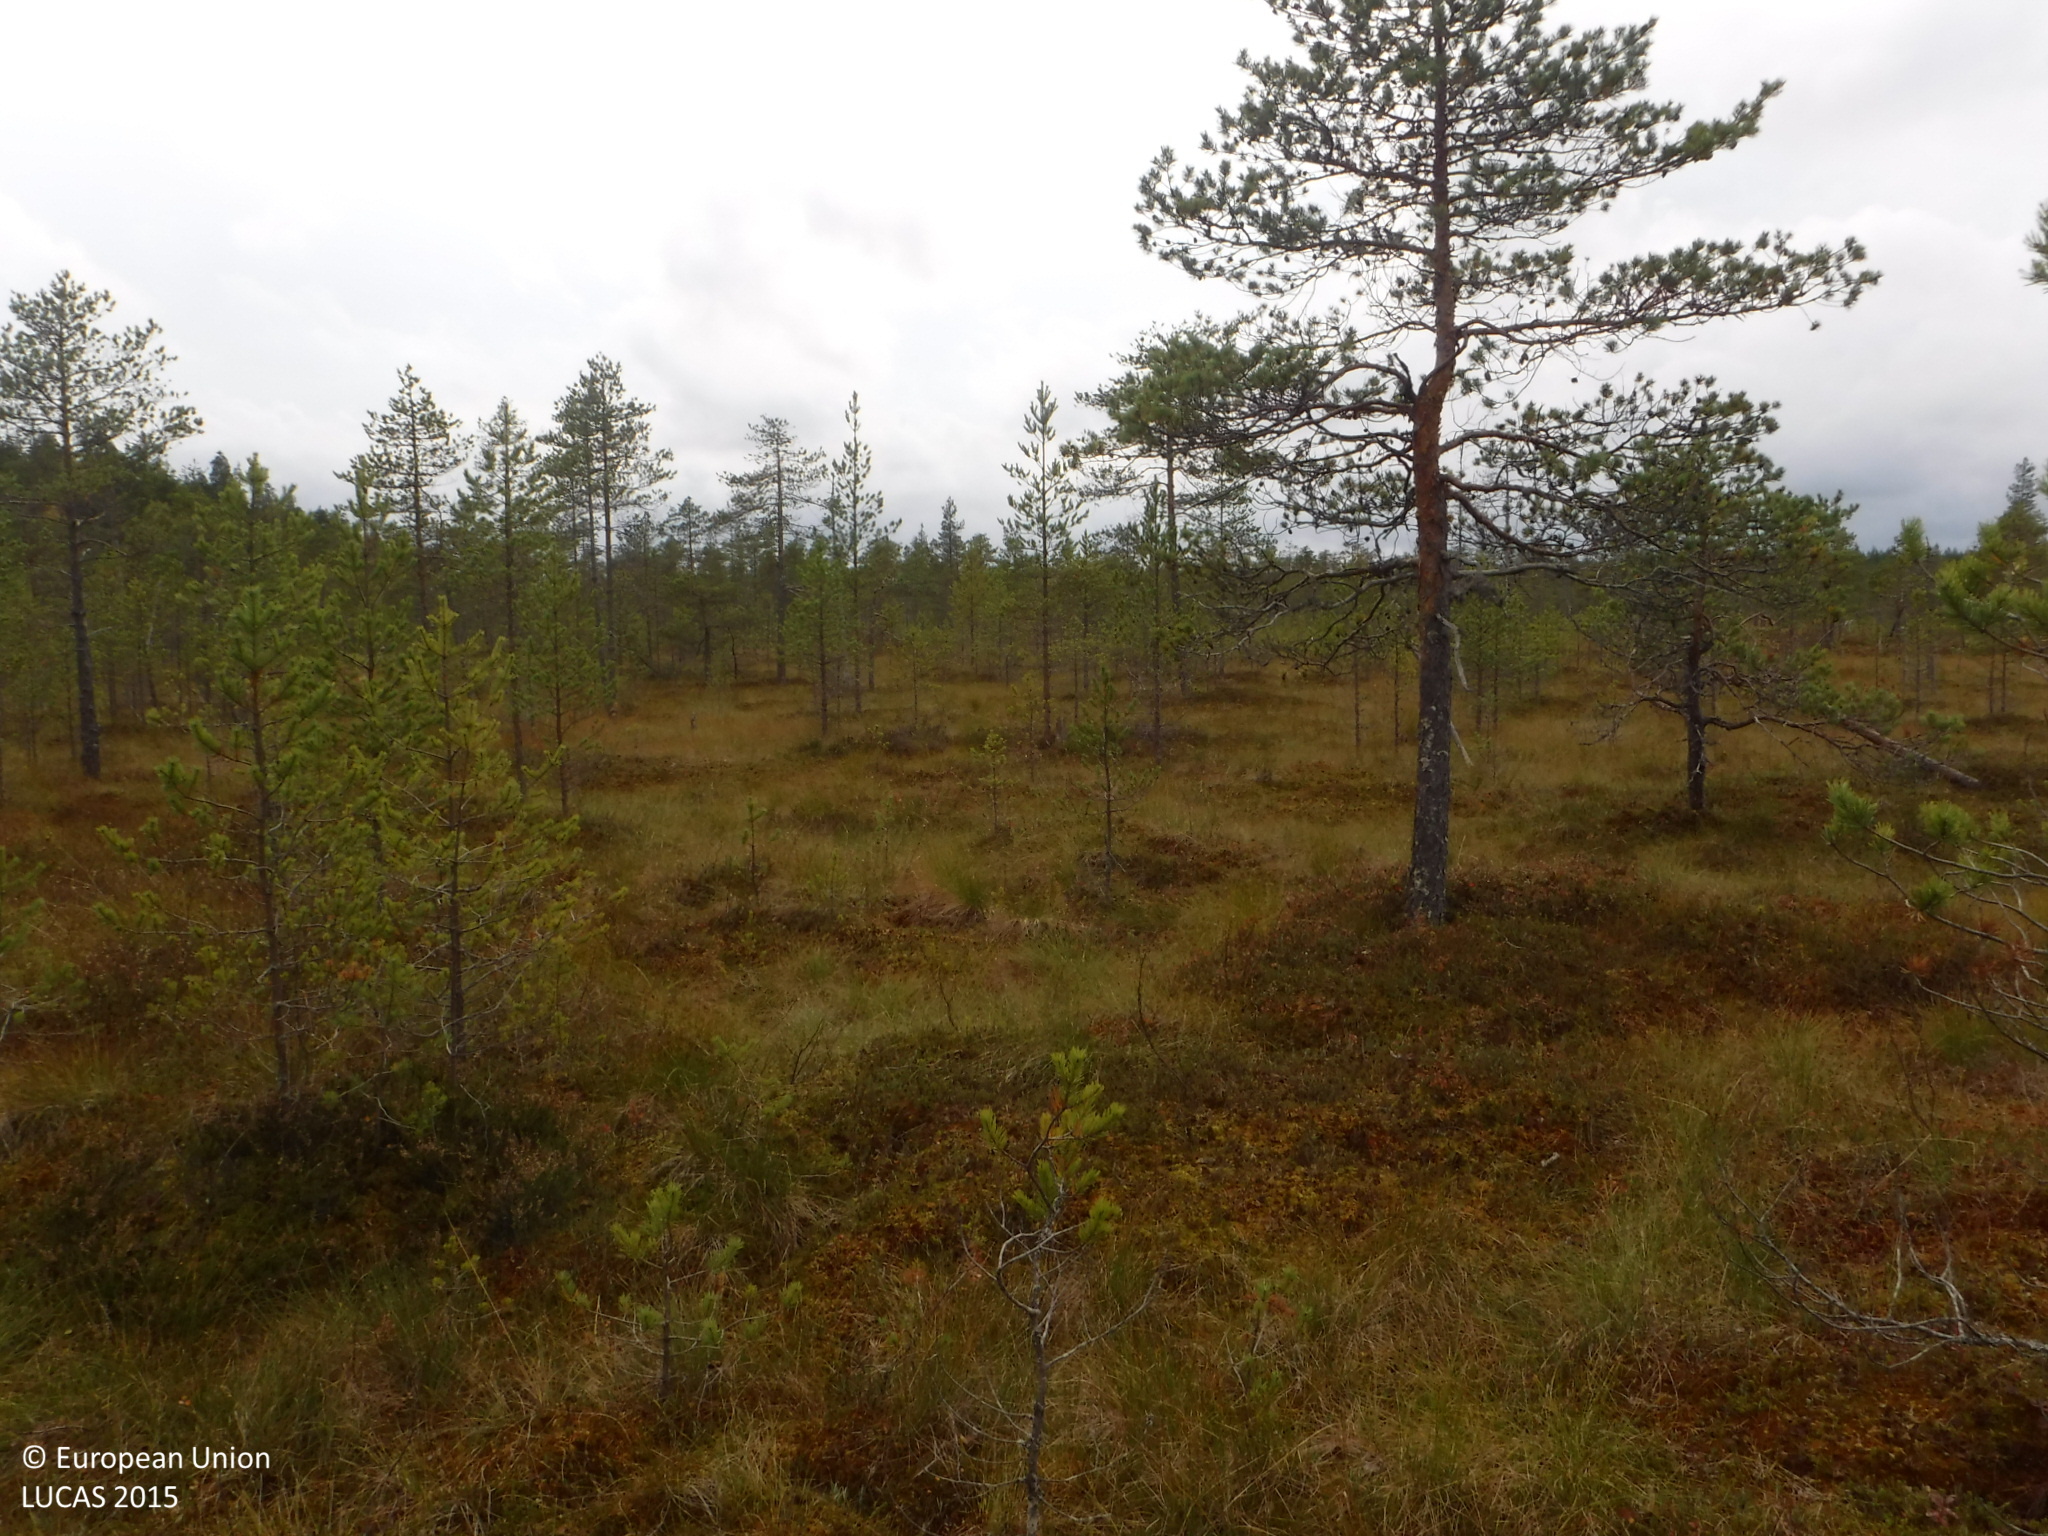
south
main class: Woodland
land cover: Pine dominated coniferous woodland
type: boreal forest
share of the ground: 10 - 25 %
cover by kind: lichens and mosses 55 %, shrubs 30 %, coniferous forest trees 15 %
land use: Semi-natural and natural areas not in use
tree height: > 5 m
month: September
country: FI
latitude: 62.0566
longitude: 23.2896
